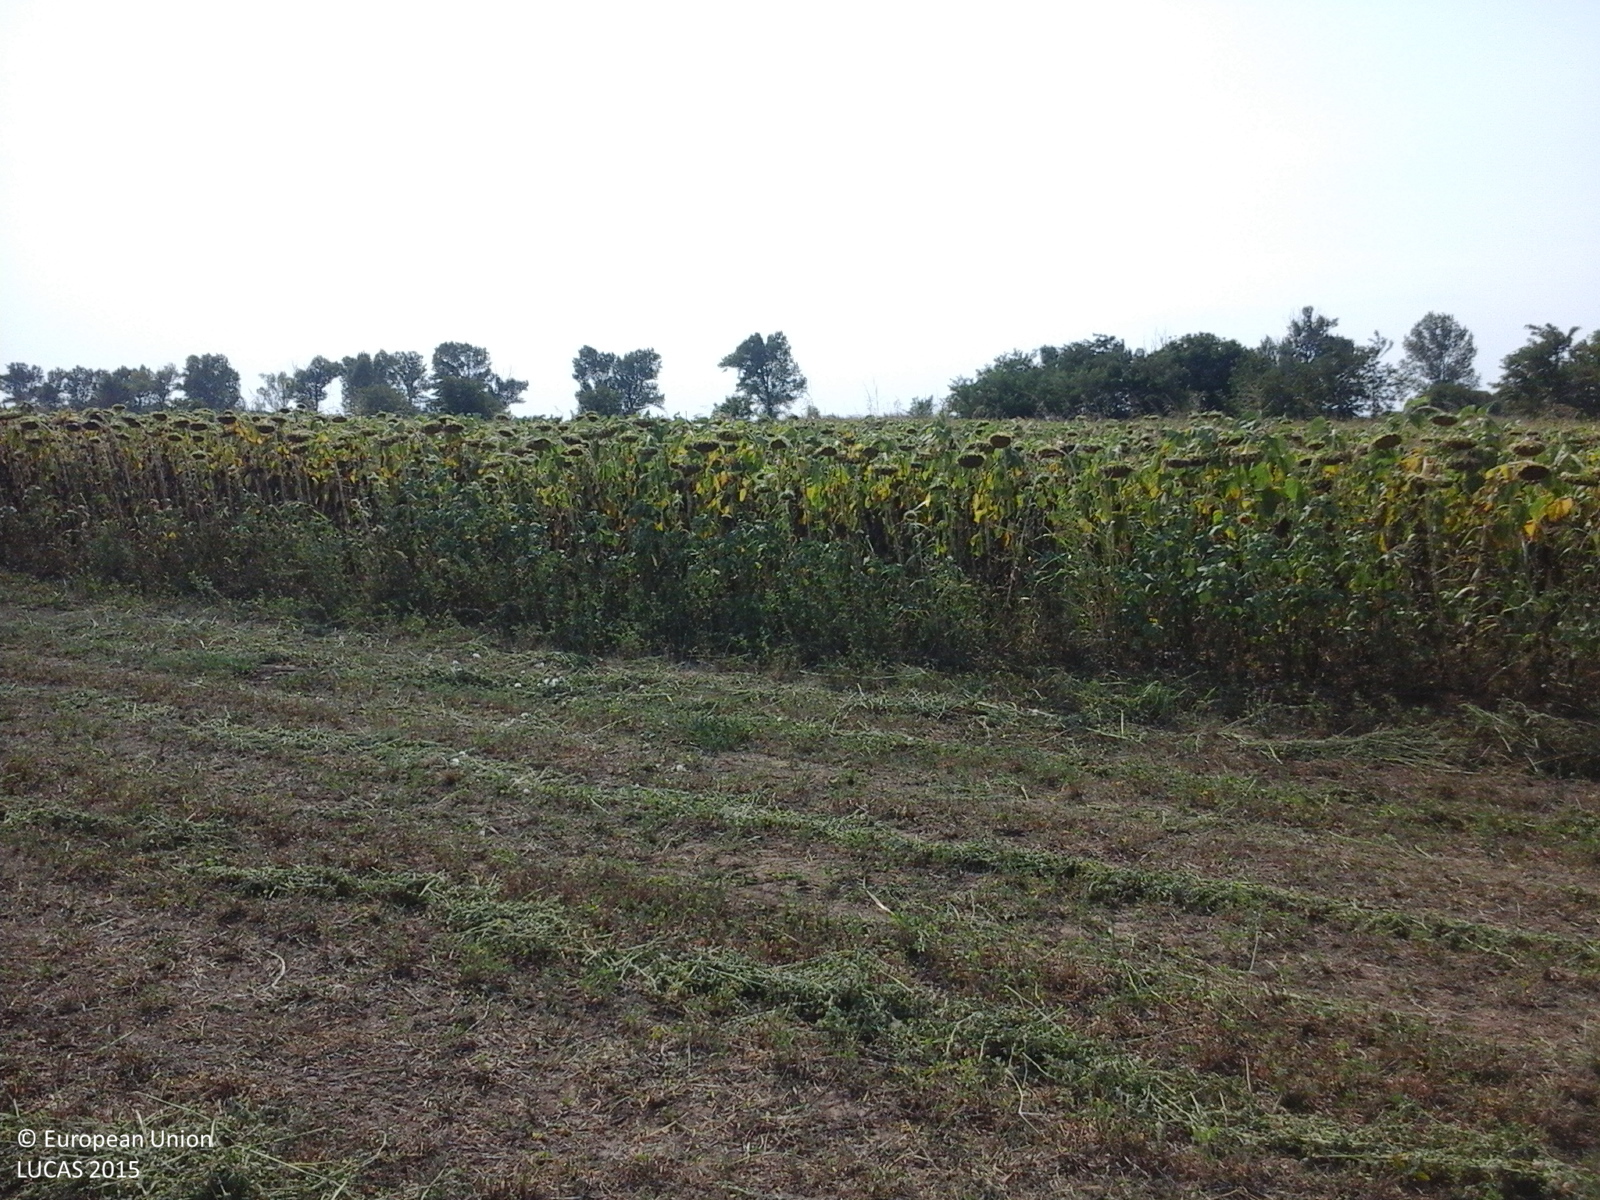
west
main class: Cropland
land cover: Lucerne
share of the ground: 50 - 75 %
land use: Agriculture (excluding fallow land and kitchen gardens)
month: August
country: RO
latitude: 45.2846
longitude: 27.4767
